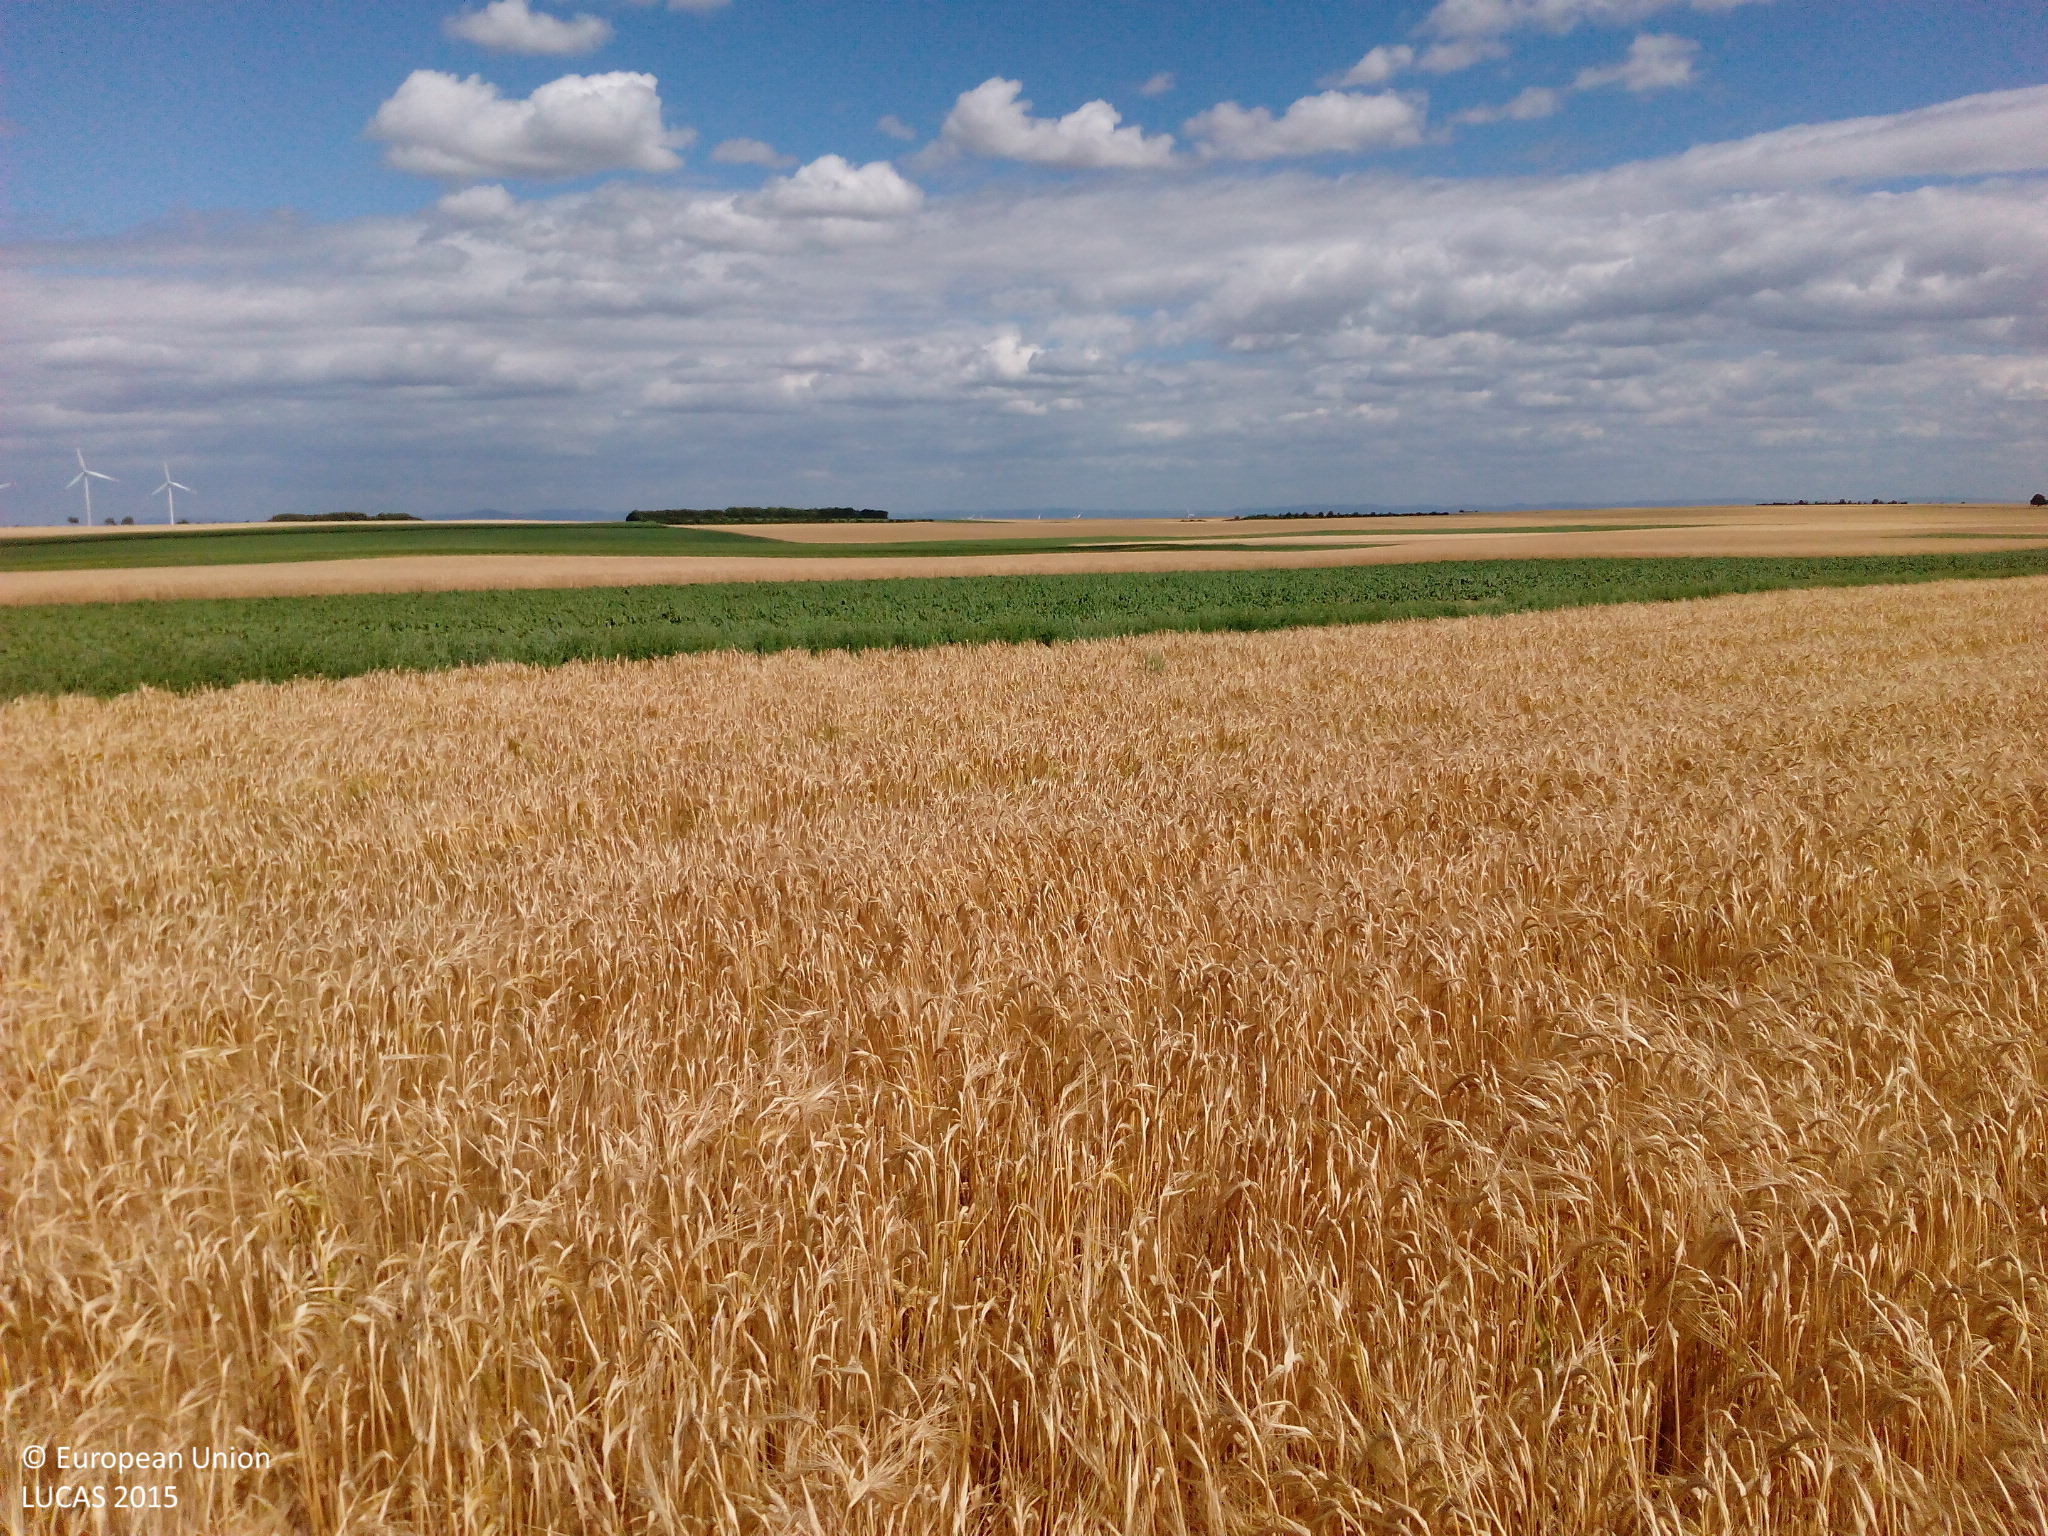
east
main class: Cropland
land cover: Barley
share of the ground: > 75 %
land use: Agriculture (excluding fallow land and kitchen gardens)
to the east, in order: Barley; Other leguminous and mixtures for fodder; Tracks; Grass margins; Sugar beet; Common wheat
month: July
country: DE
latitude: 49.6657
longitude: 8.1578
